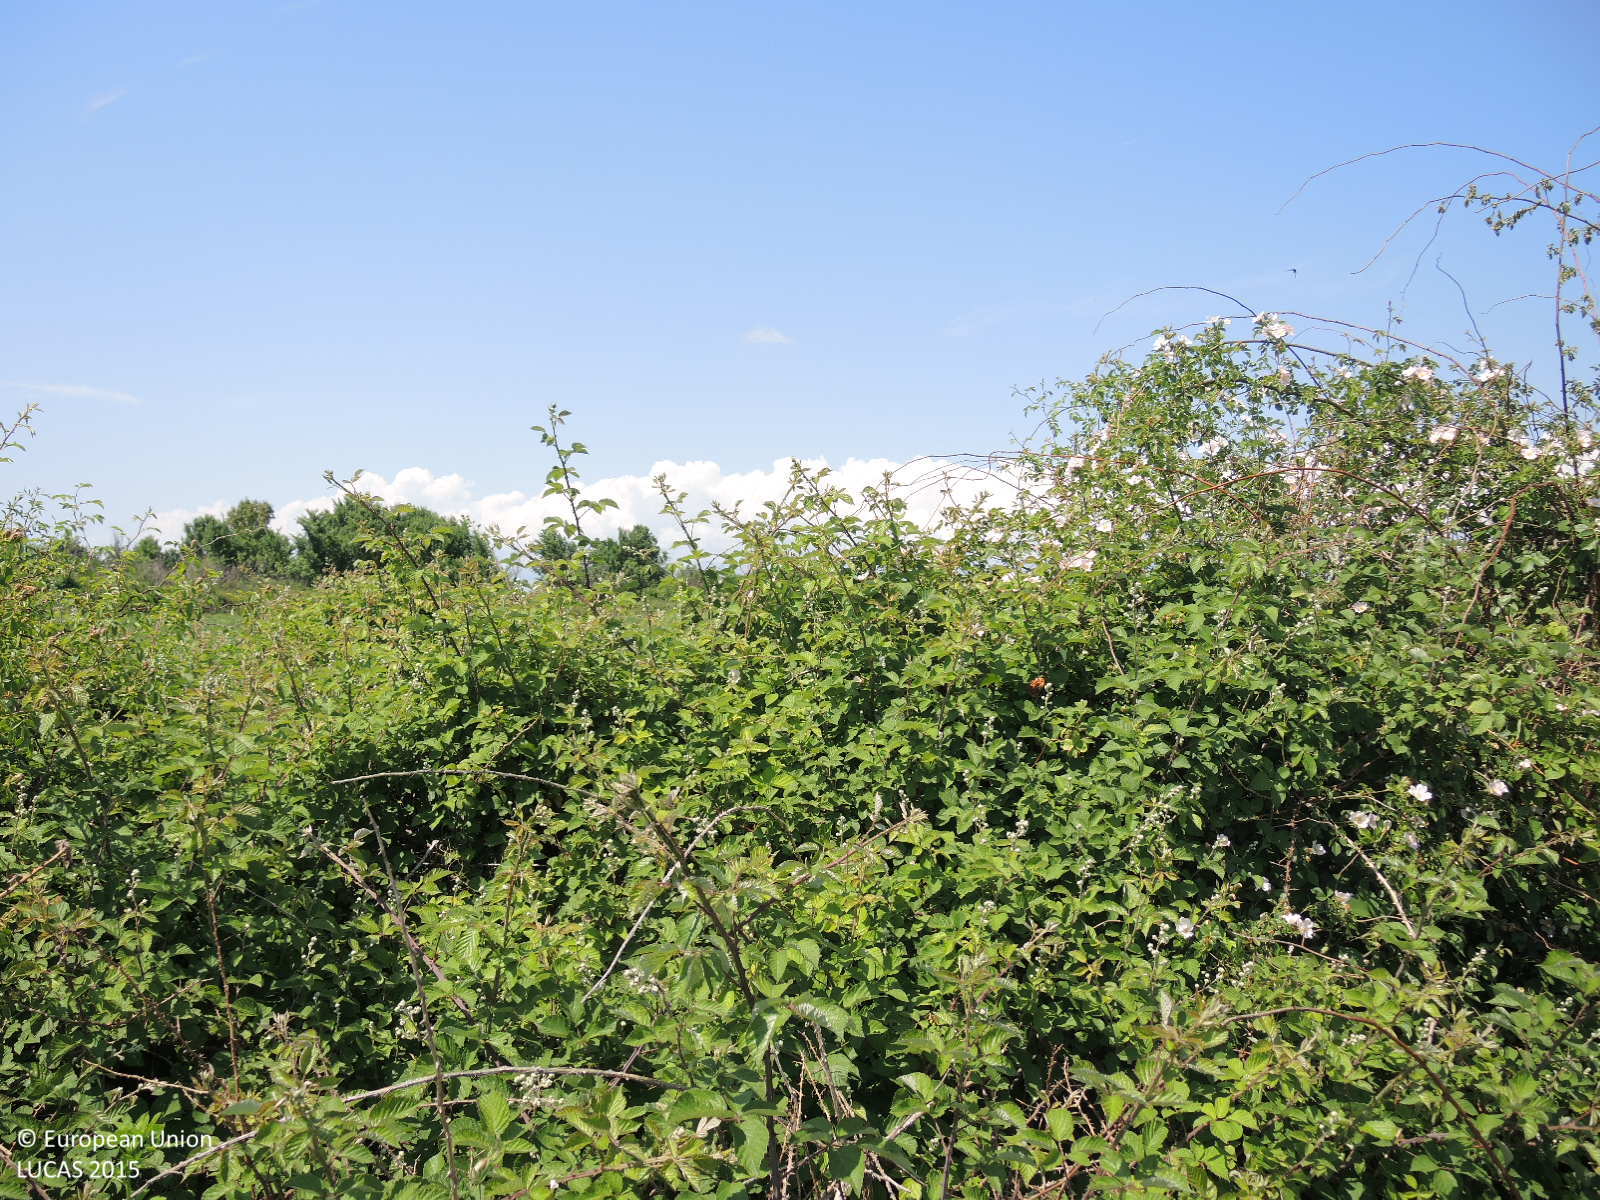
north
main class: Shrubland
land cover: Shrubland without tree cover
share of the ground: 50 - 75 %
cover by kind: shrubs 70 %, herbaceous plants 20 %, unconsolidated bare surface 10 %
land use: Semi-natural and natural areas not in use
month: May
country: HR
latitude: 44.1155
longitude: 15.4774
